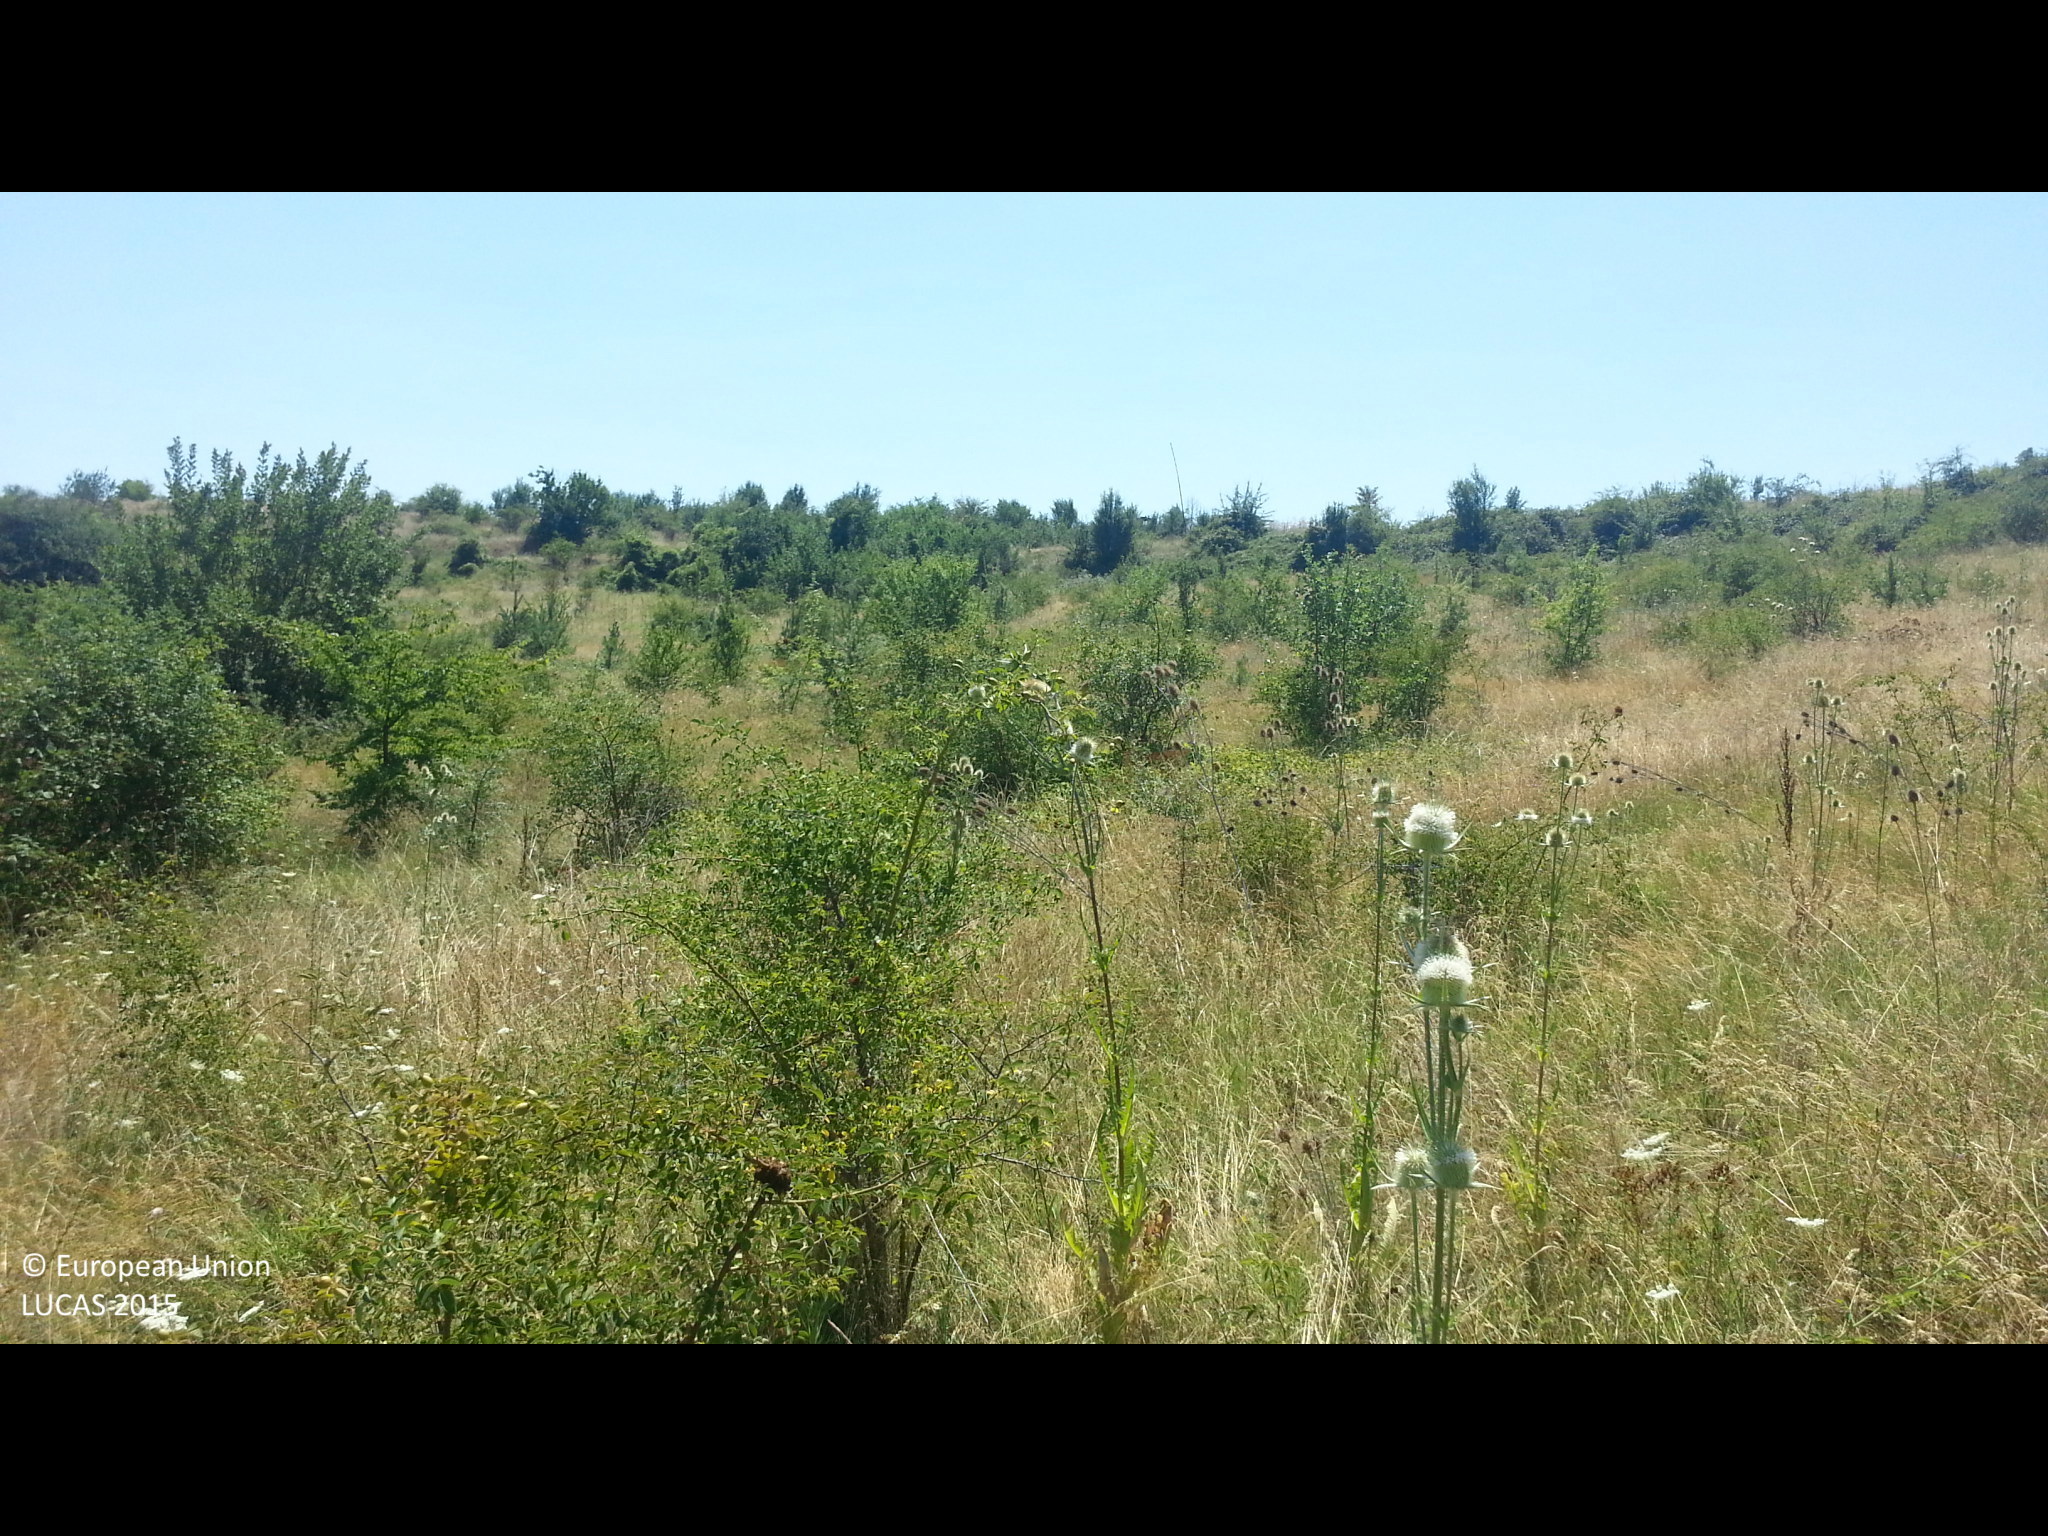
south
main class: Grassland
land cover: Grassland with sparse tree/shrub cover
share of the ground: > 75 %
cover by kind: herbaceous plants 90 %, broadleaved forest trees 5 %, shrubs 5 %
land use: Semi-natural and natural areas not in use
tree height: < 5 m
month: August
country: BG
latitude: 42.3137
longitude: 22.6515
